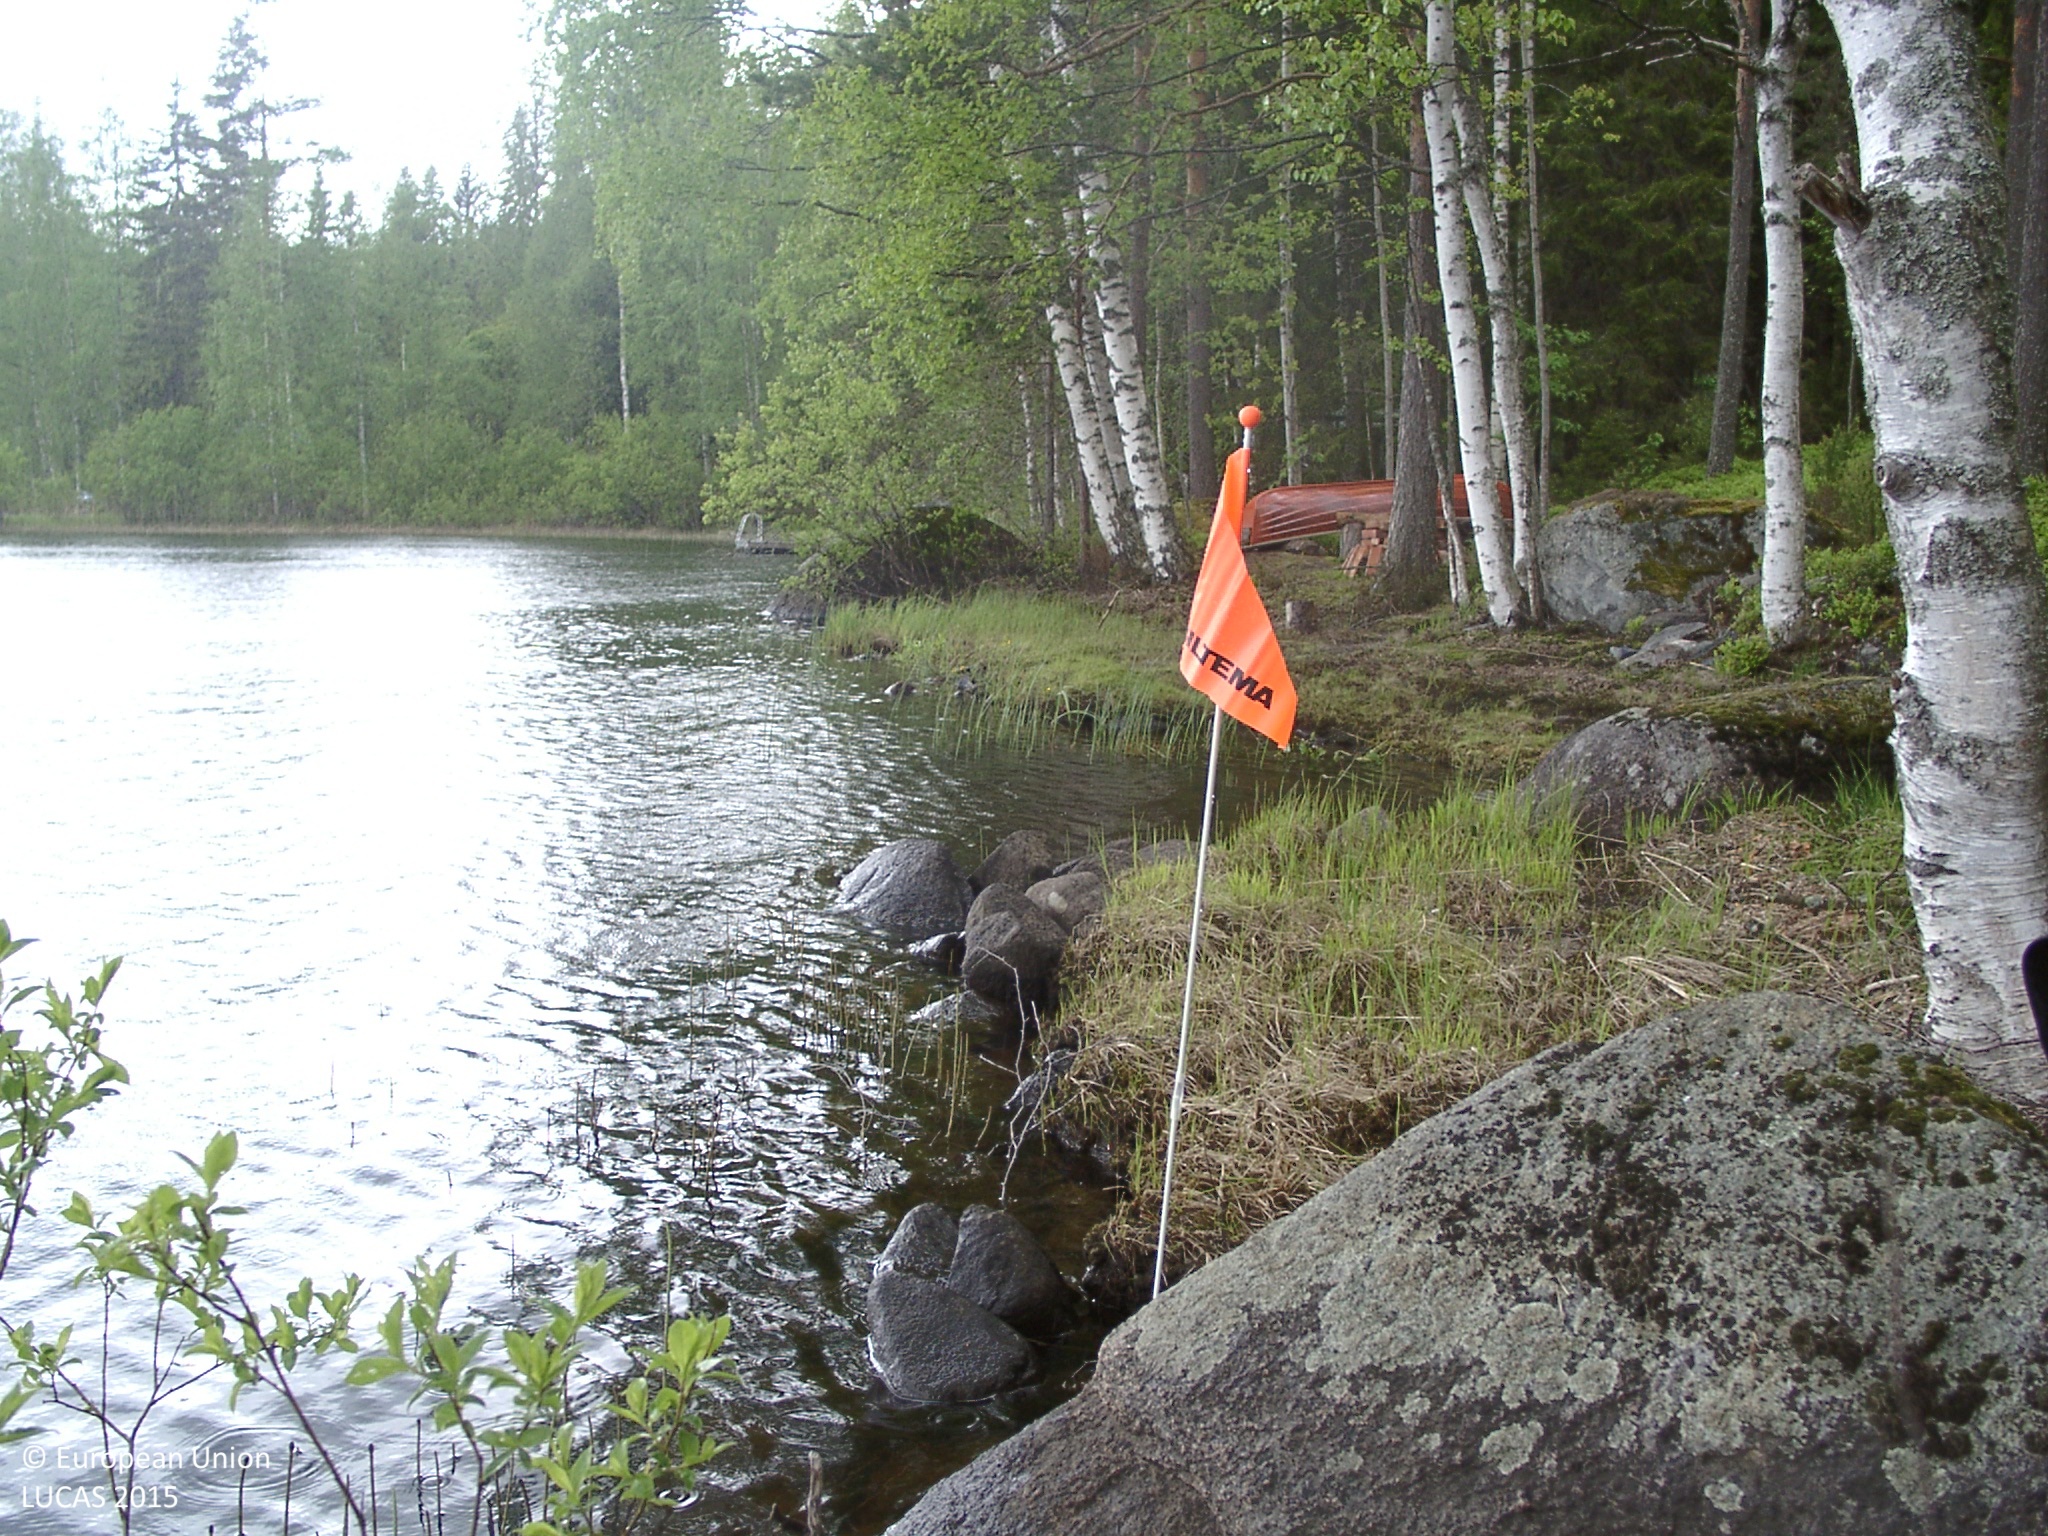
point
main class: Woodland
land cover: Other mixed woodland
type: boreal forest
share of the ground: 50 - 75 %
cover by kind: coniferous forest trees 35 %, shrubs 35 %, broadleaved forest trees 25 %, herbaceous plants 5 %
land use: Amenities, museums, leisure
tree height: > 5 m
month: June
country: FI
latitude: 62.2106
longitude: 25.4761
